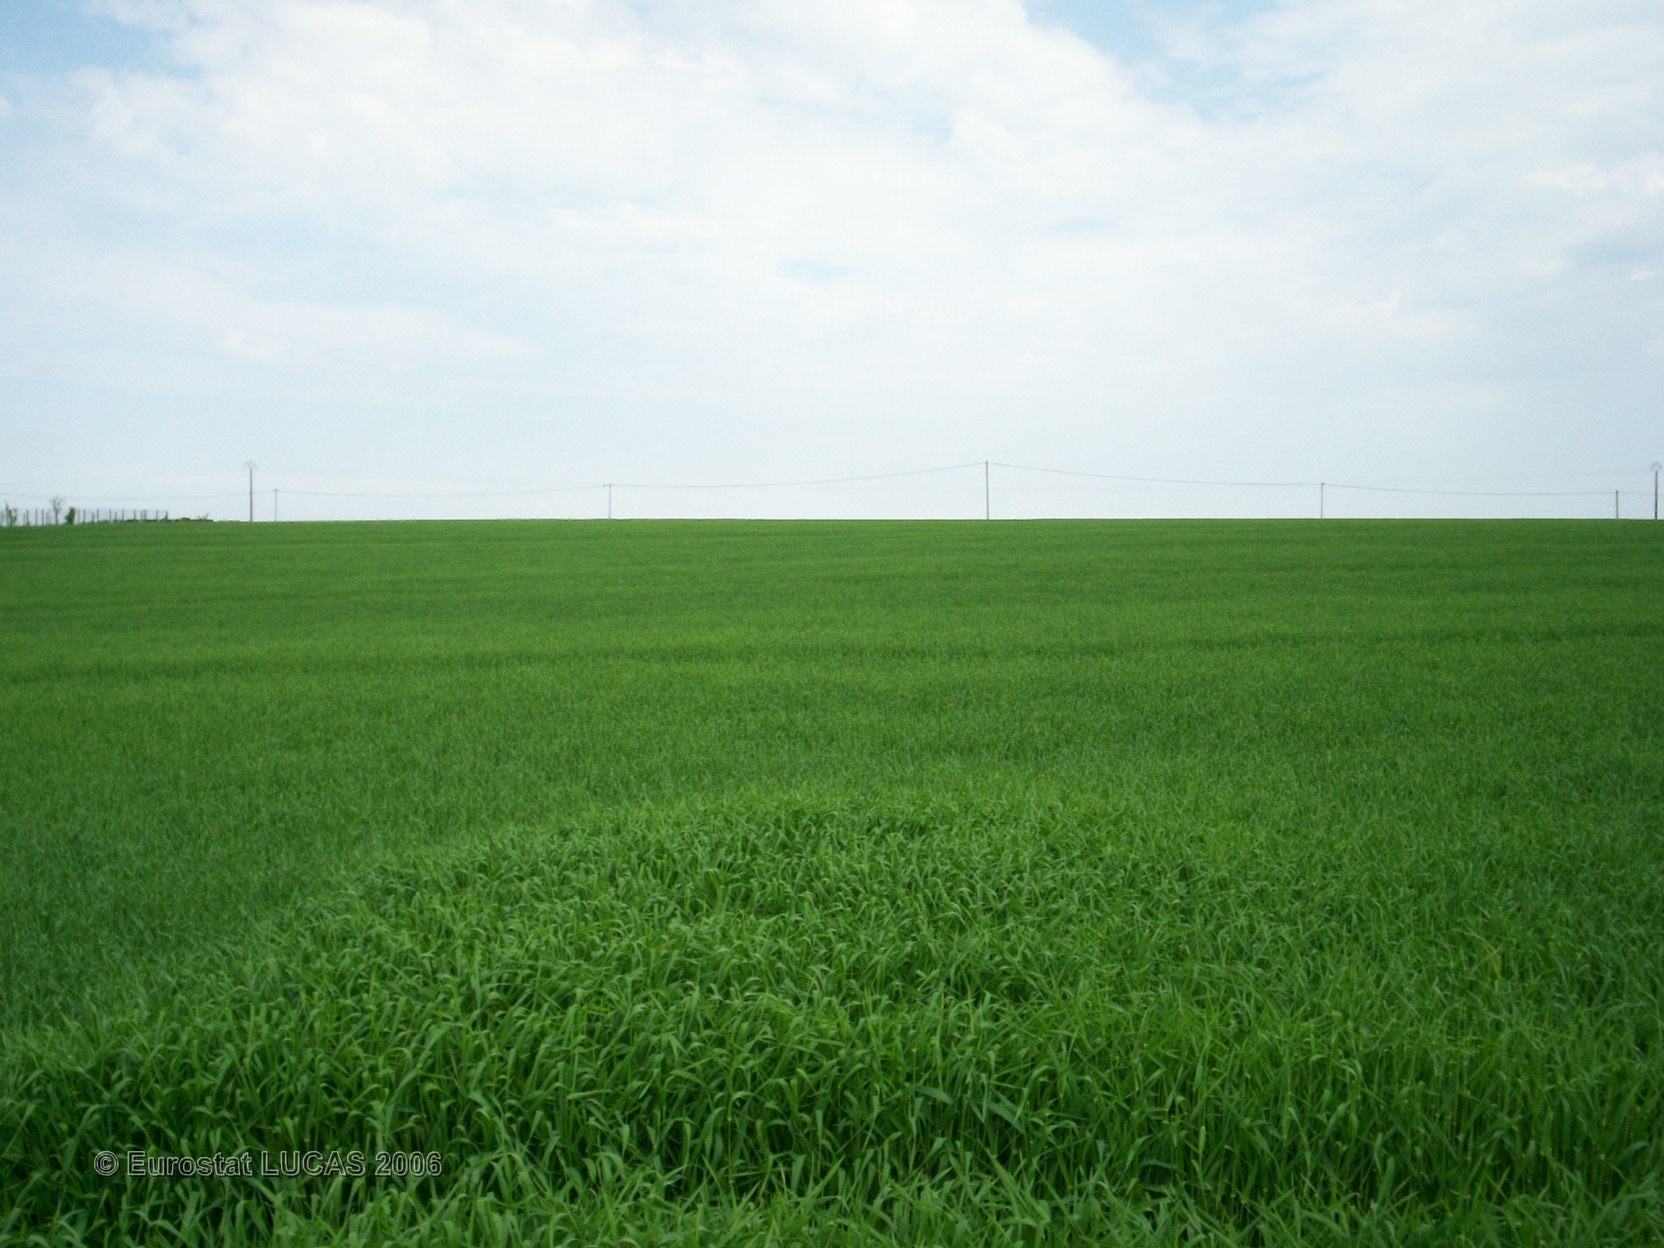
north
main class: Cropland
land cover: Barley
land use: Agriculture (excluding fallow land and kitchen gardens)
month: May
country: FR
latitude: 47.8123
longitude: -2.7085
